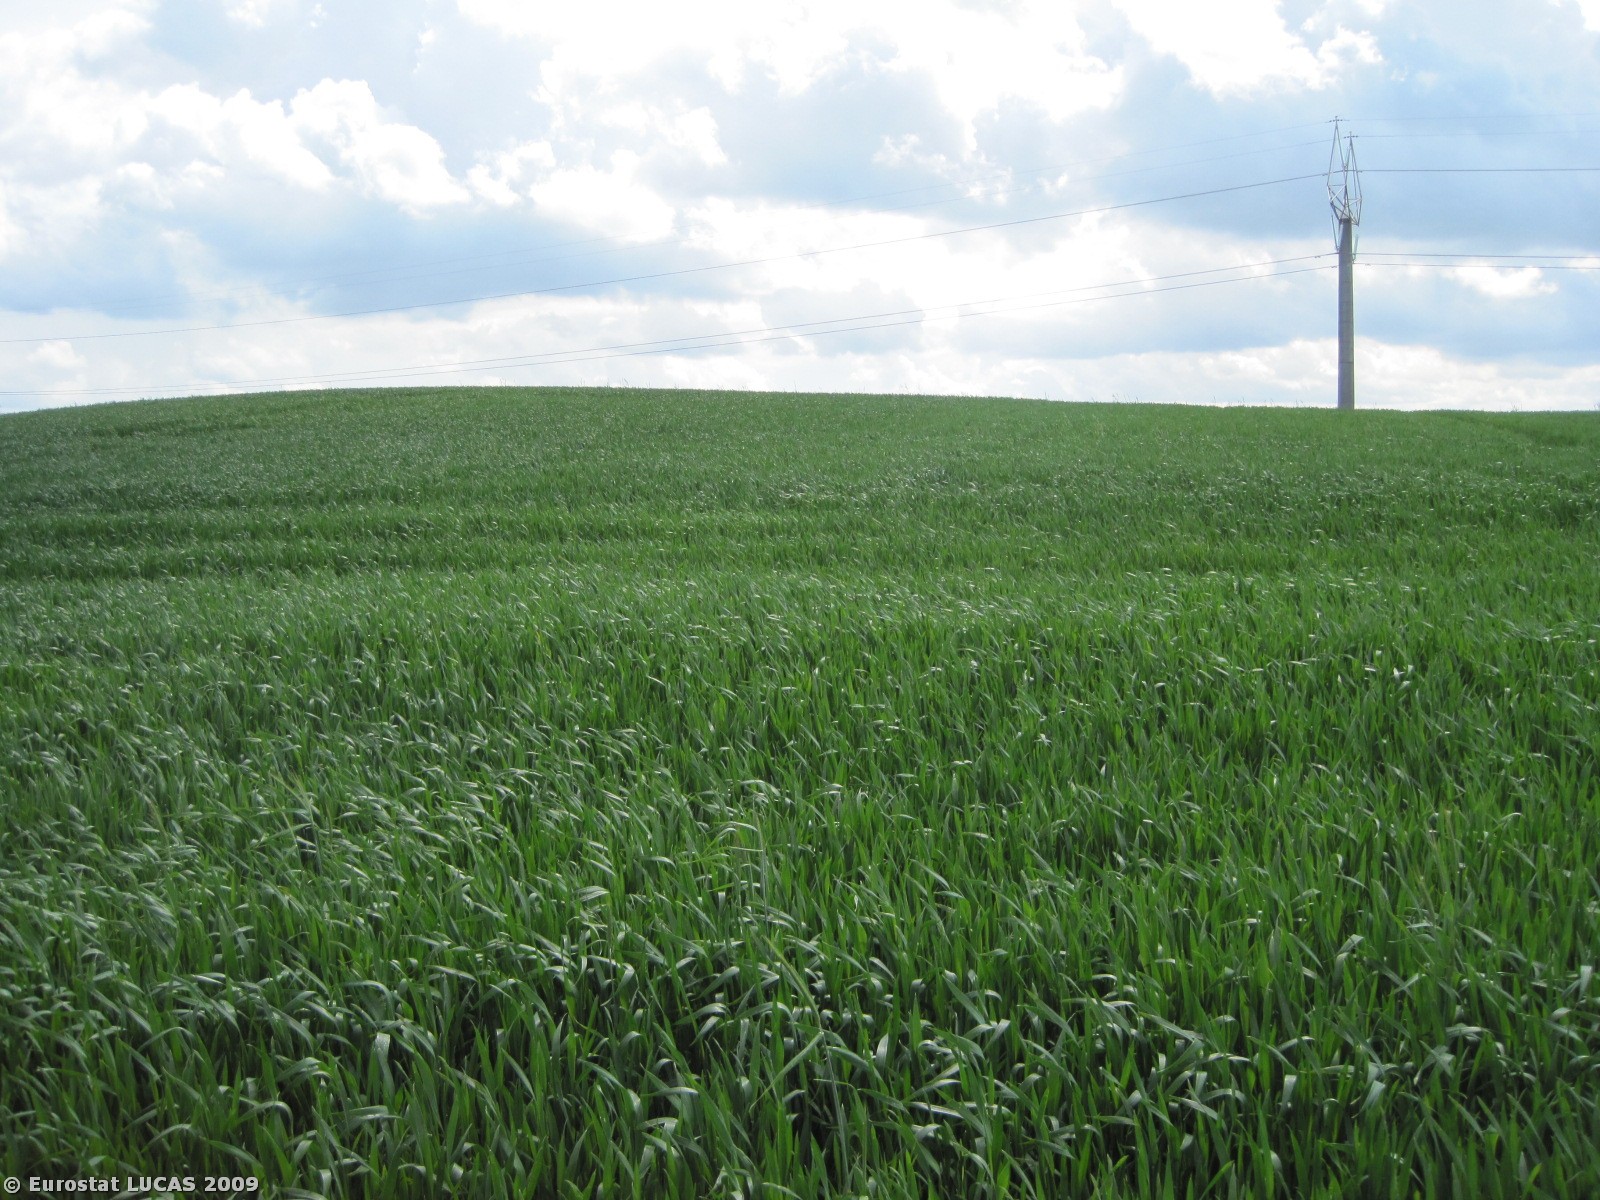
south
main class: Woodland
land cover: Broadleaved woodland
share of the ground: > 75 %
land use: Unused
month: May
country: DK
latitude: 56.7089
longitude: 9.7879
